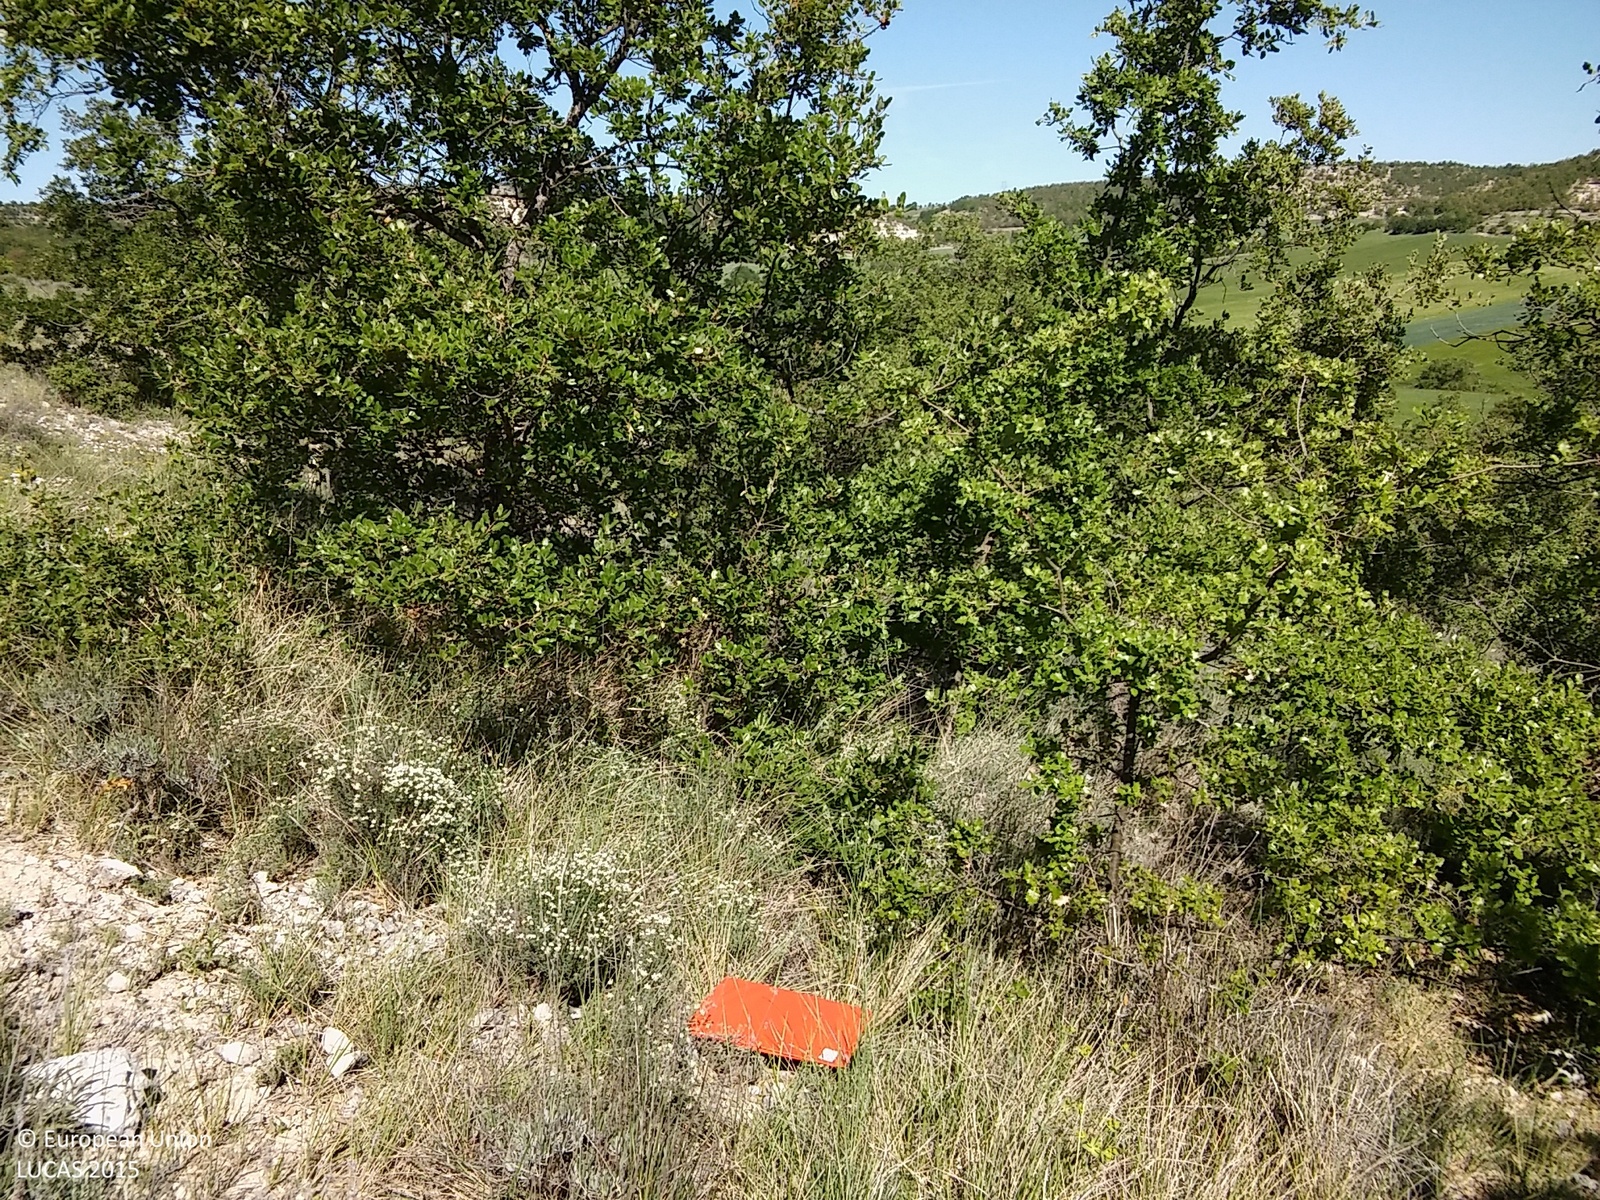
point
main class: Shrubland
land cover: Shrubland with sparse tree cover
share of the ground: 25 - 50 %
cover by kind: shrubs 50 %, unconsolidated bare surface 25 %, herbaceous plants 20 %, broadleaved forest trees 5 %
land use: Semi-natural and natural areas not in use
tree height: > 5 m
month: May
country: ES
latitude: 41.5129
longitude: -3.9903
